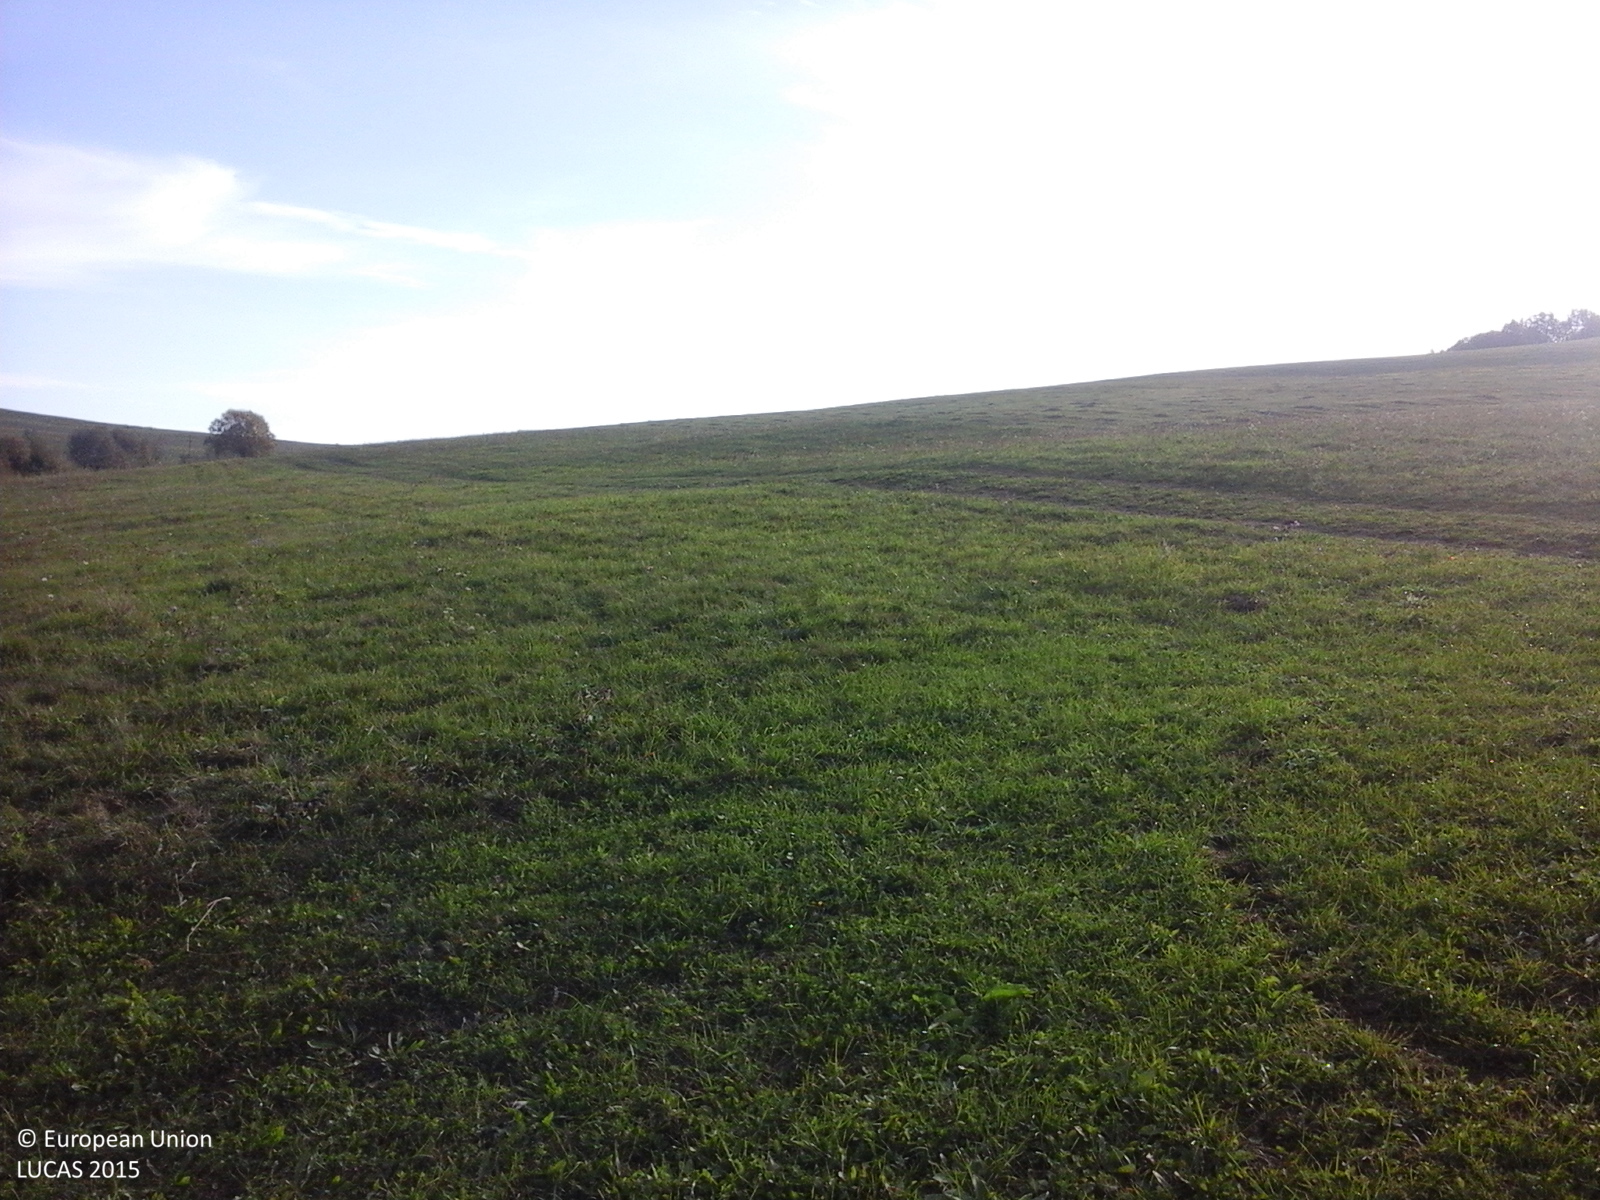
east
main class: Grassland
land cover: Grassland without tree/shrub cover
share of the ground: > 75 %
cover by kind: herbaceous plants 100 %
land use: Agriculture (excluding fallow land and kitchen gardens)
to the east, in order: Grassland without tree/shrub cover; Tracks; Grassland without tree/shrub cover
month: October
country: RO
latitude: 46.3602
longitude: 25.2966
